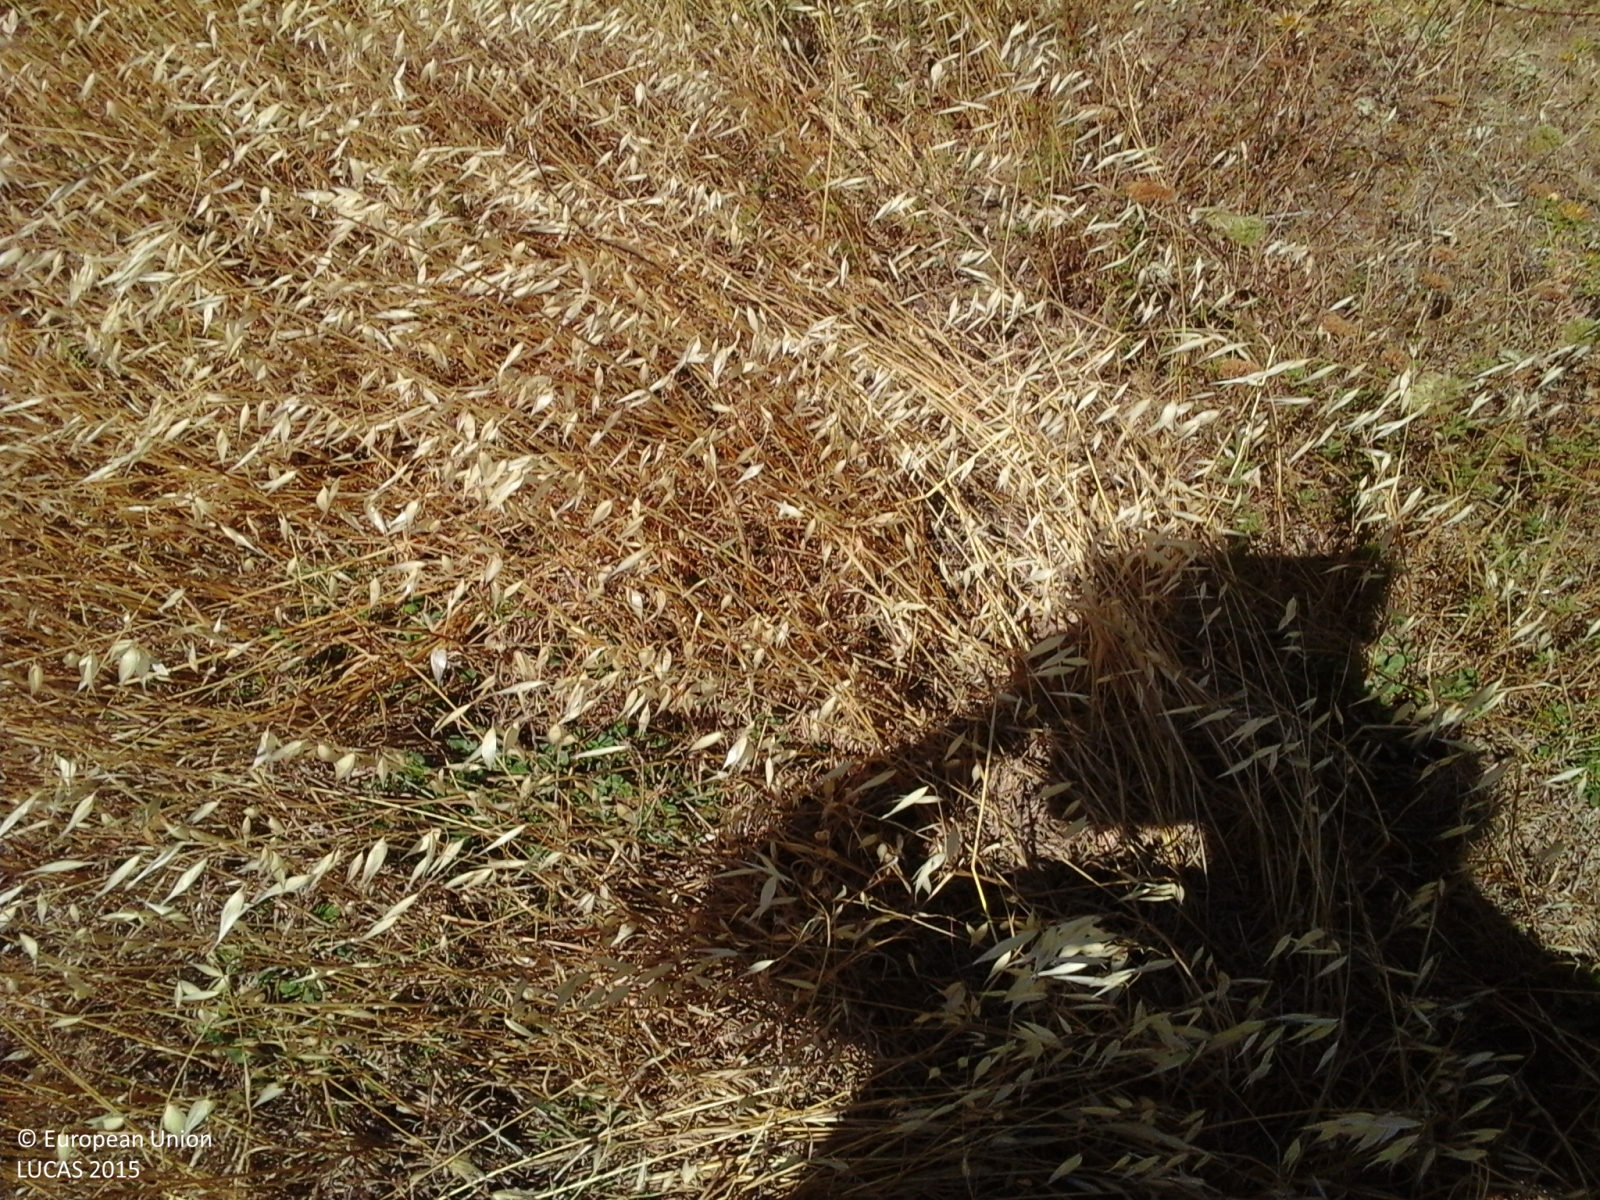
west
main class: Grassland
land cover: Grassland without tree/shrub cover
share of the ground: > 75 %
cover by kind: herbaceous plants 90 %, consolidated bare surface 10 %
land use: Agriculture (excluding fallow land and kitchen gardens)
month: July
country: IT
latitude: 37.1152
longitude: 14.8358
